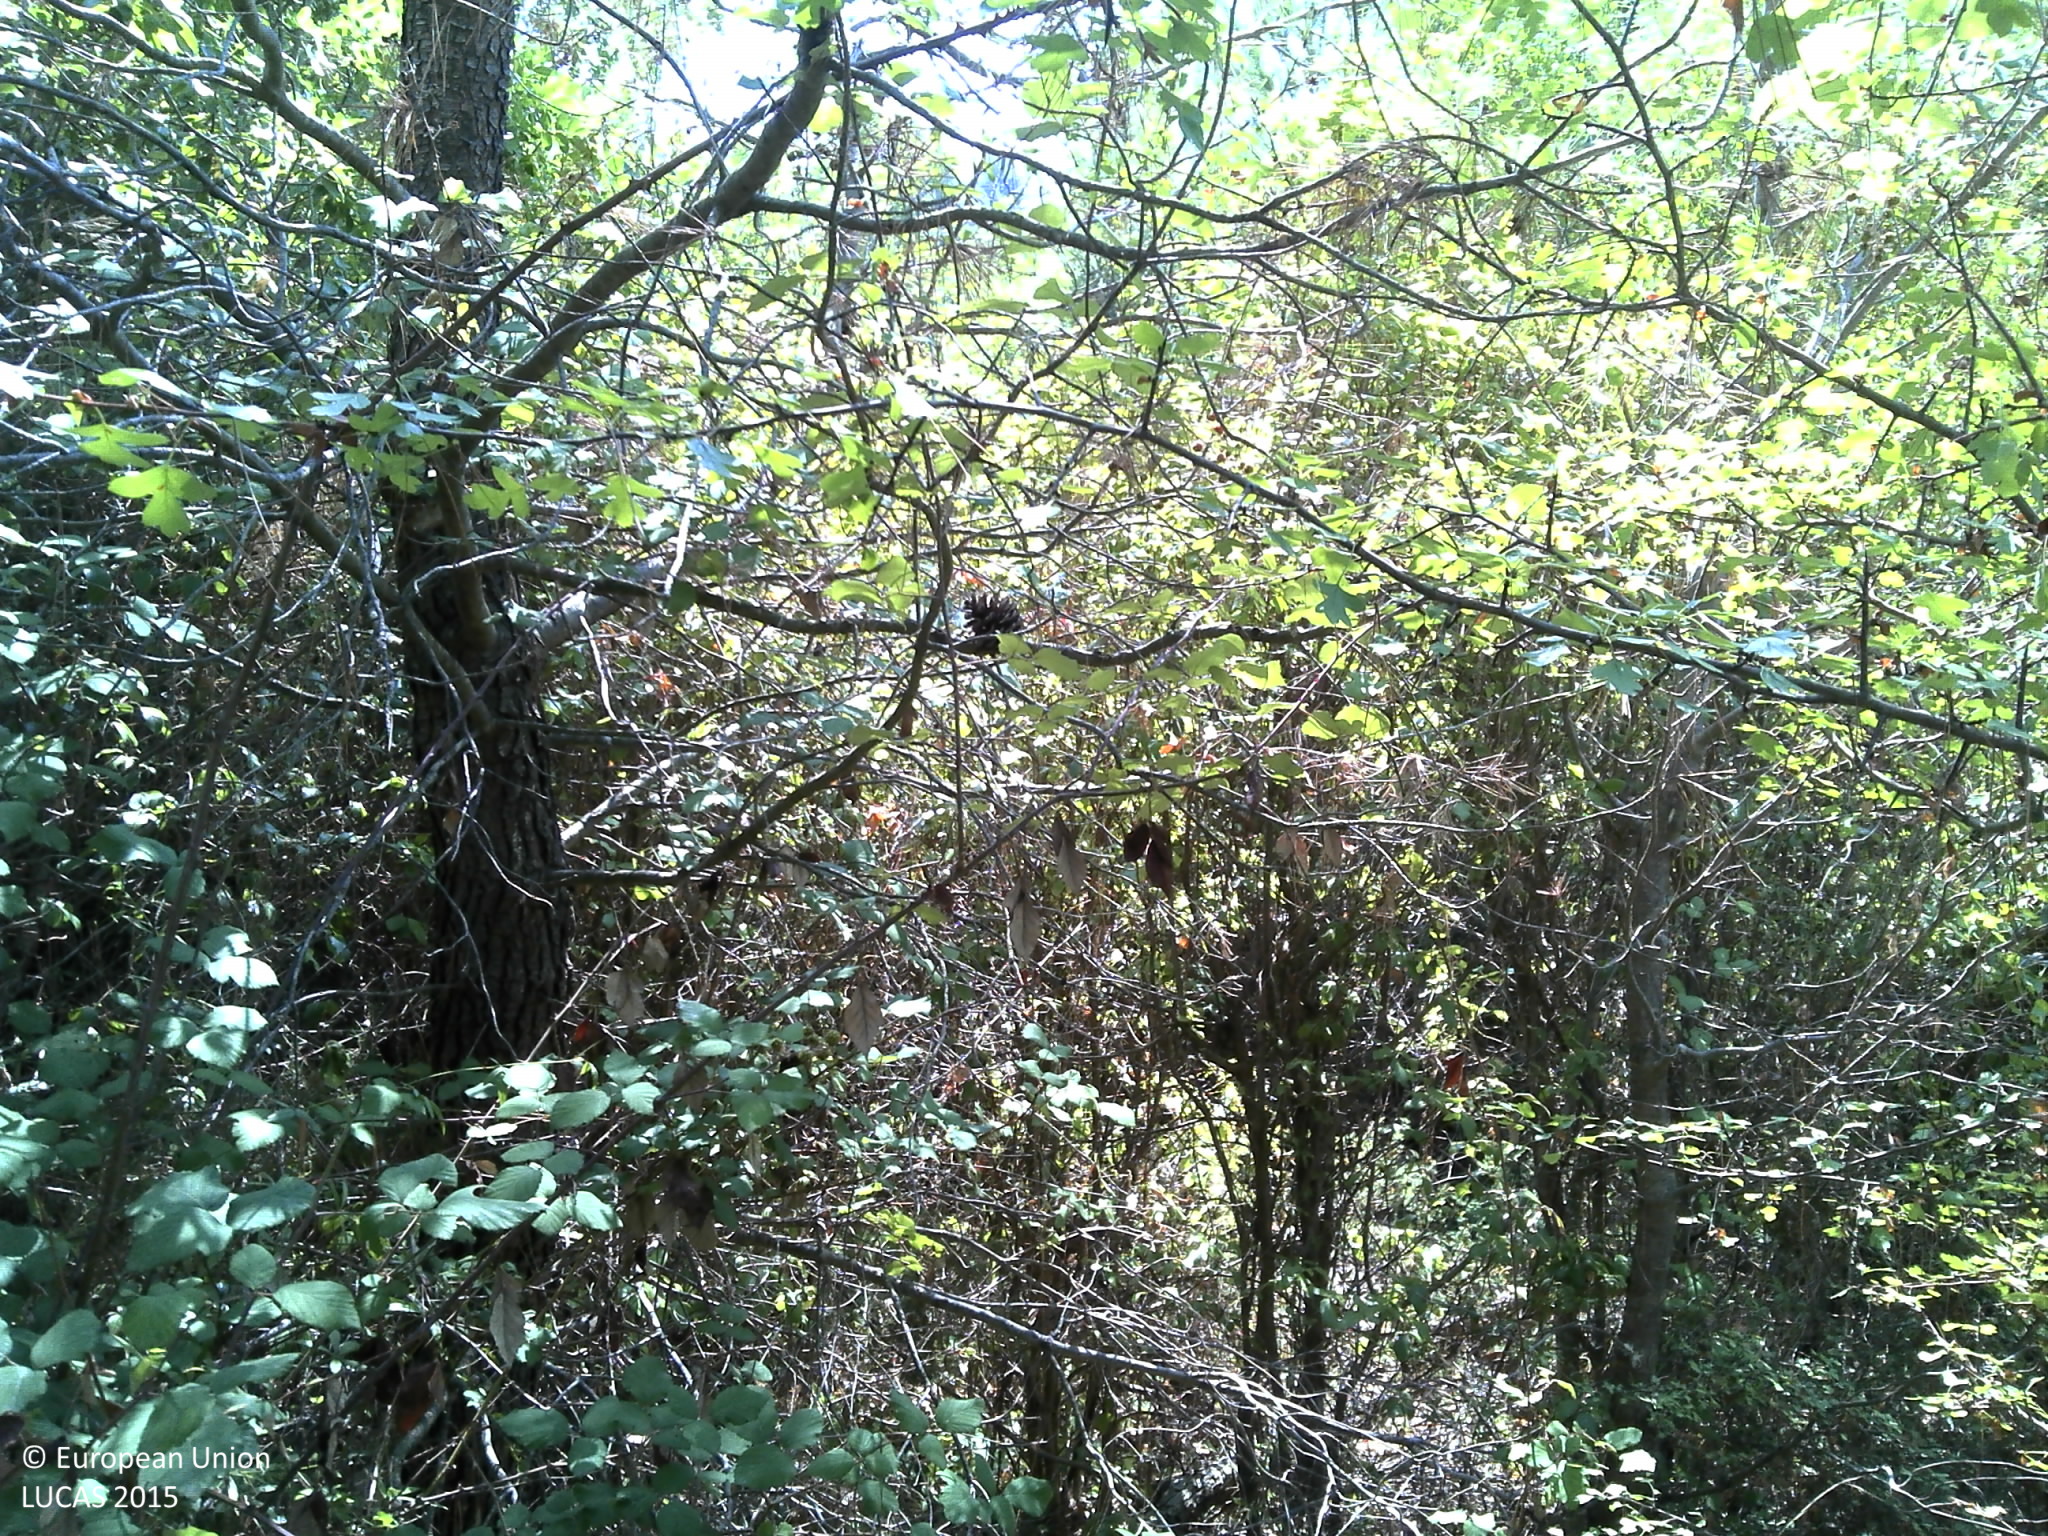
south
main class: Woodland
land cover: Other mixed woodland
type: coniferous forest of the mediterranean region
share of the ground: > 75 %
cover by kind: shrubs 45 %, coniferous forest trees 30 %, broadleaved forest trees 25 %
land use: Semi-natural and natural areas not in use
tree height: > 5 m
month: August
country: HR
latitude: 42.9121
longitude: 16.8360
